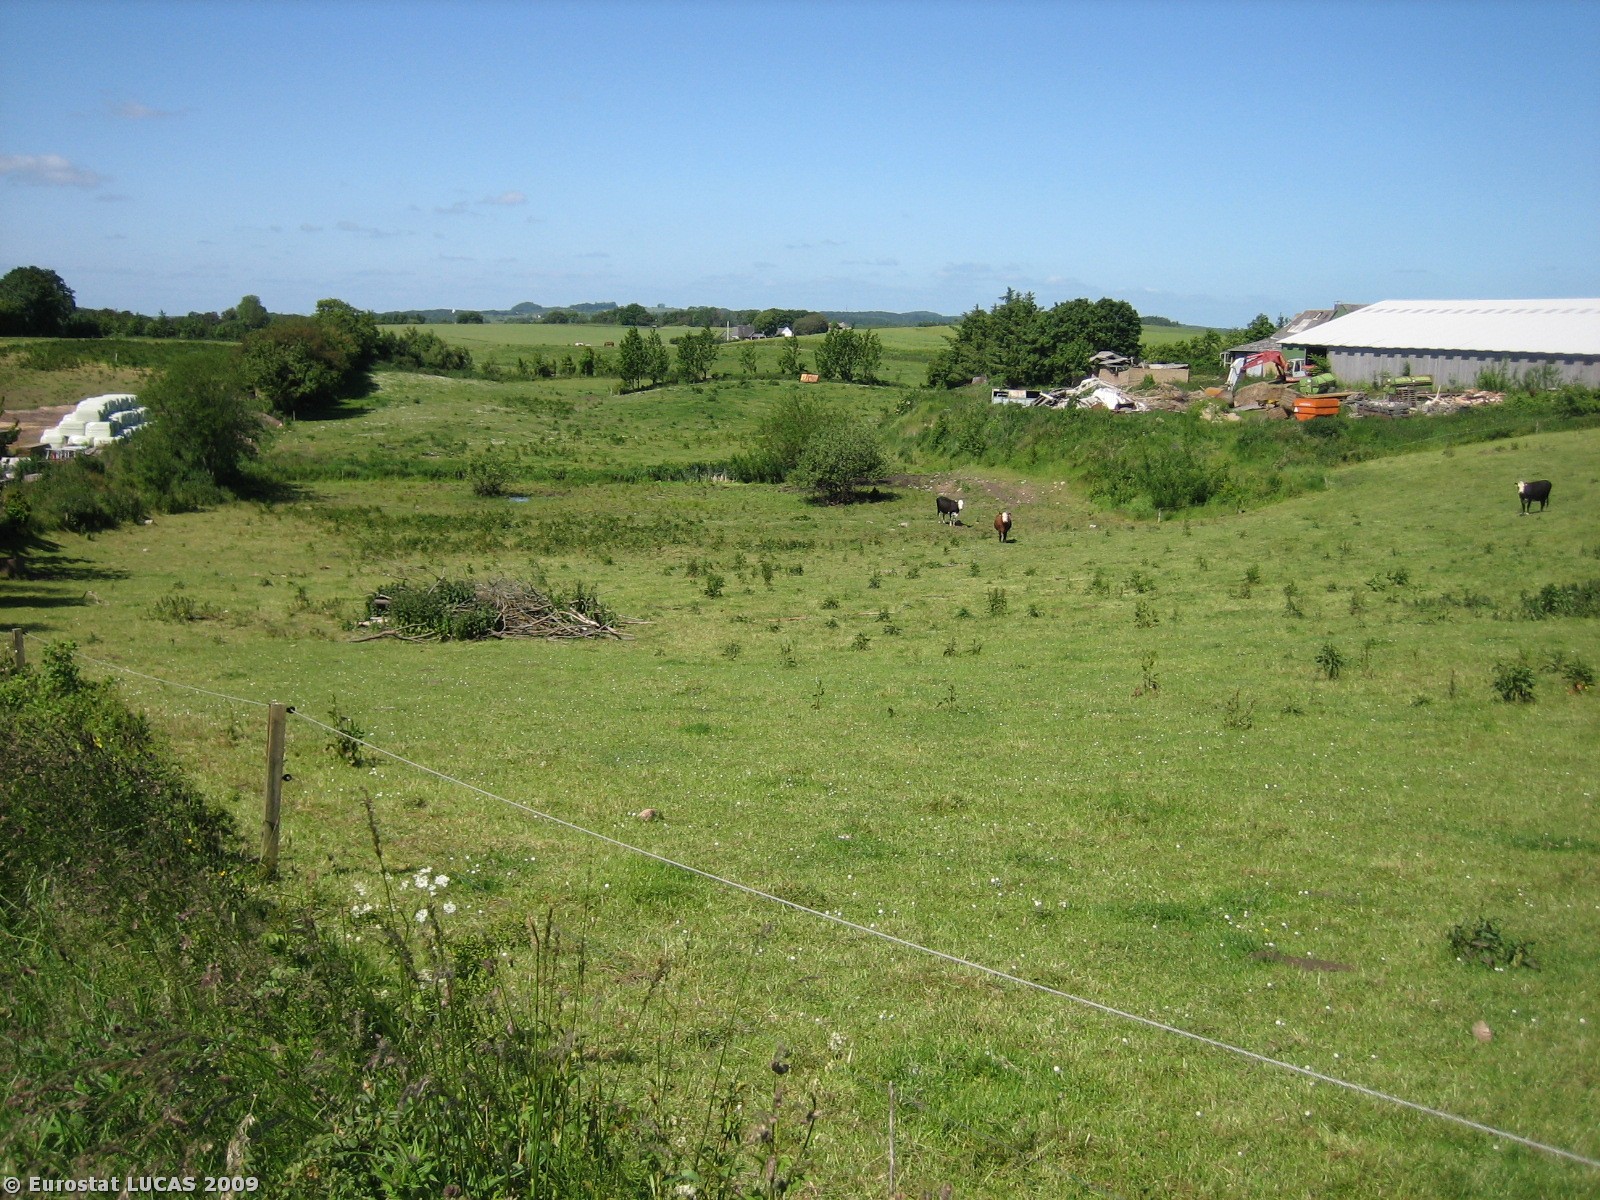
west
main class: Grassland
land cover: Grassland without tree/shrub cover
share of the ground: > 75 %
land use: Agriculture (excluding fallow land and kitchen gardens)
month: June
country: DK
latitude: 55.9720
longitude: 9.9200
